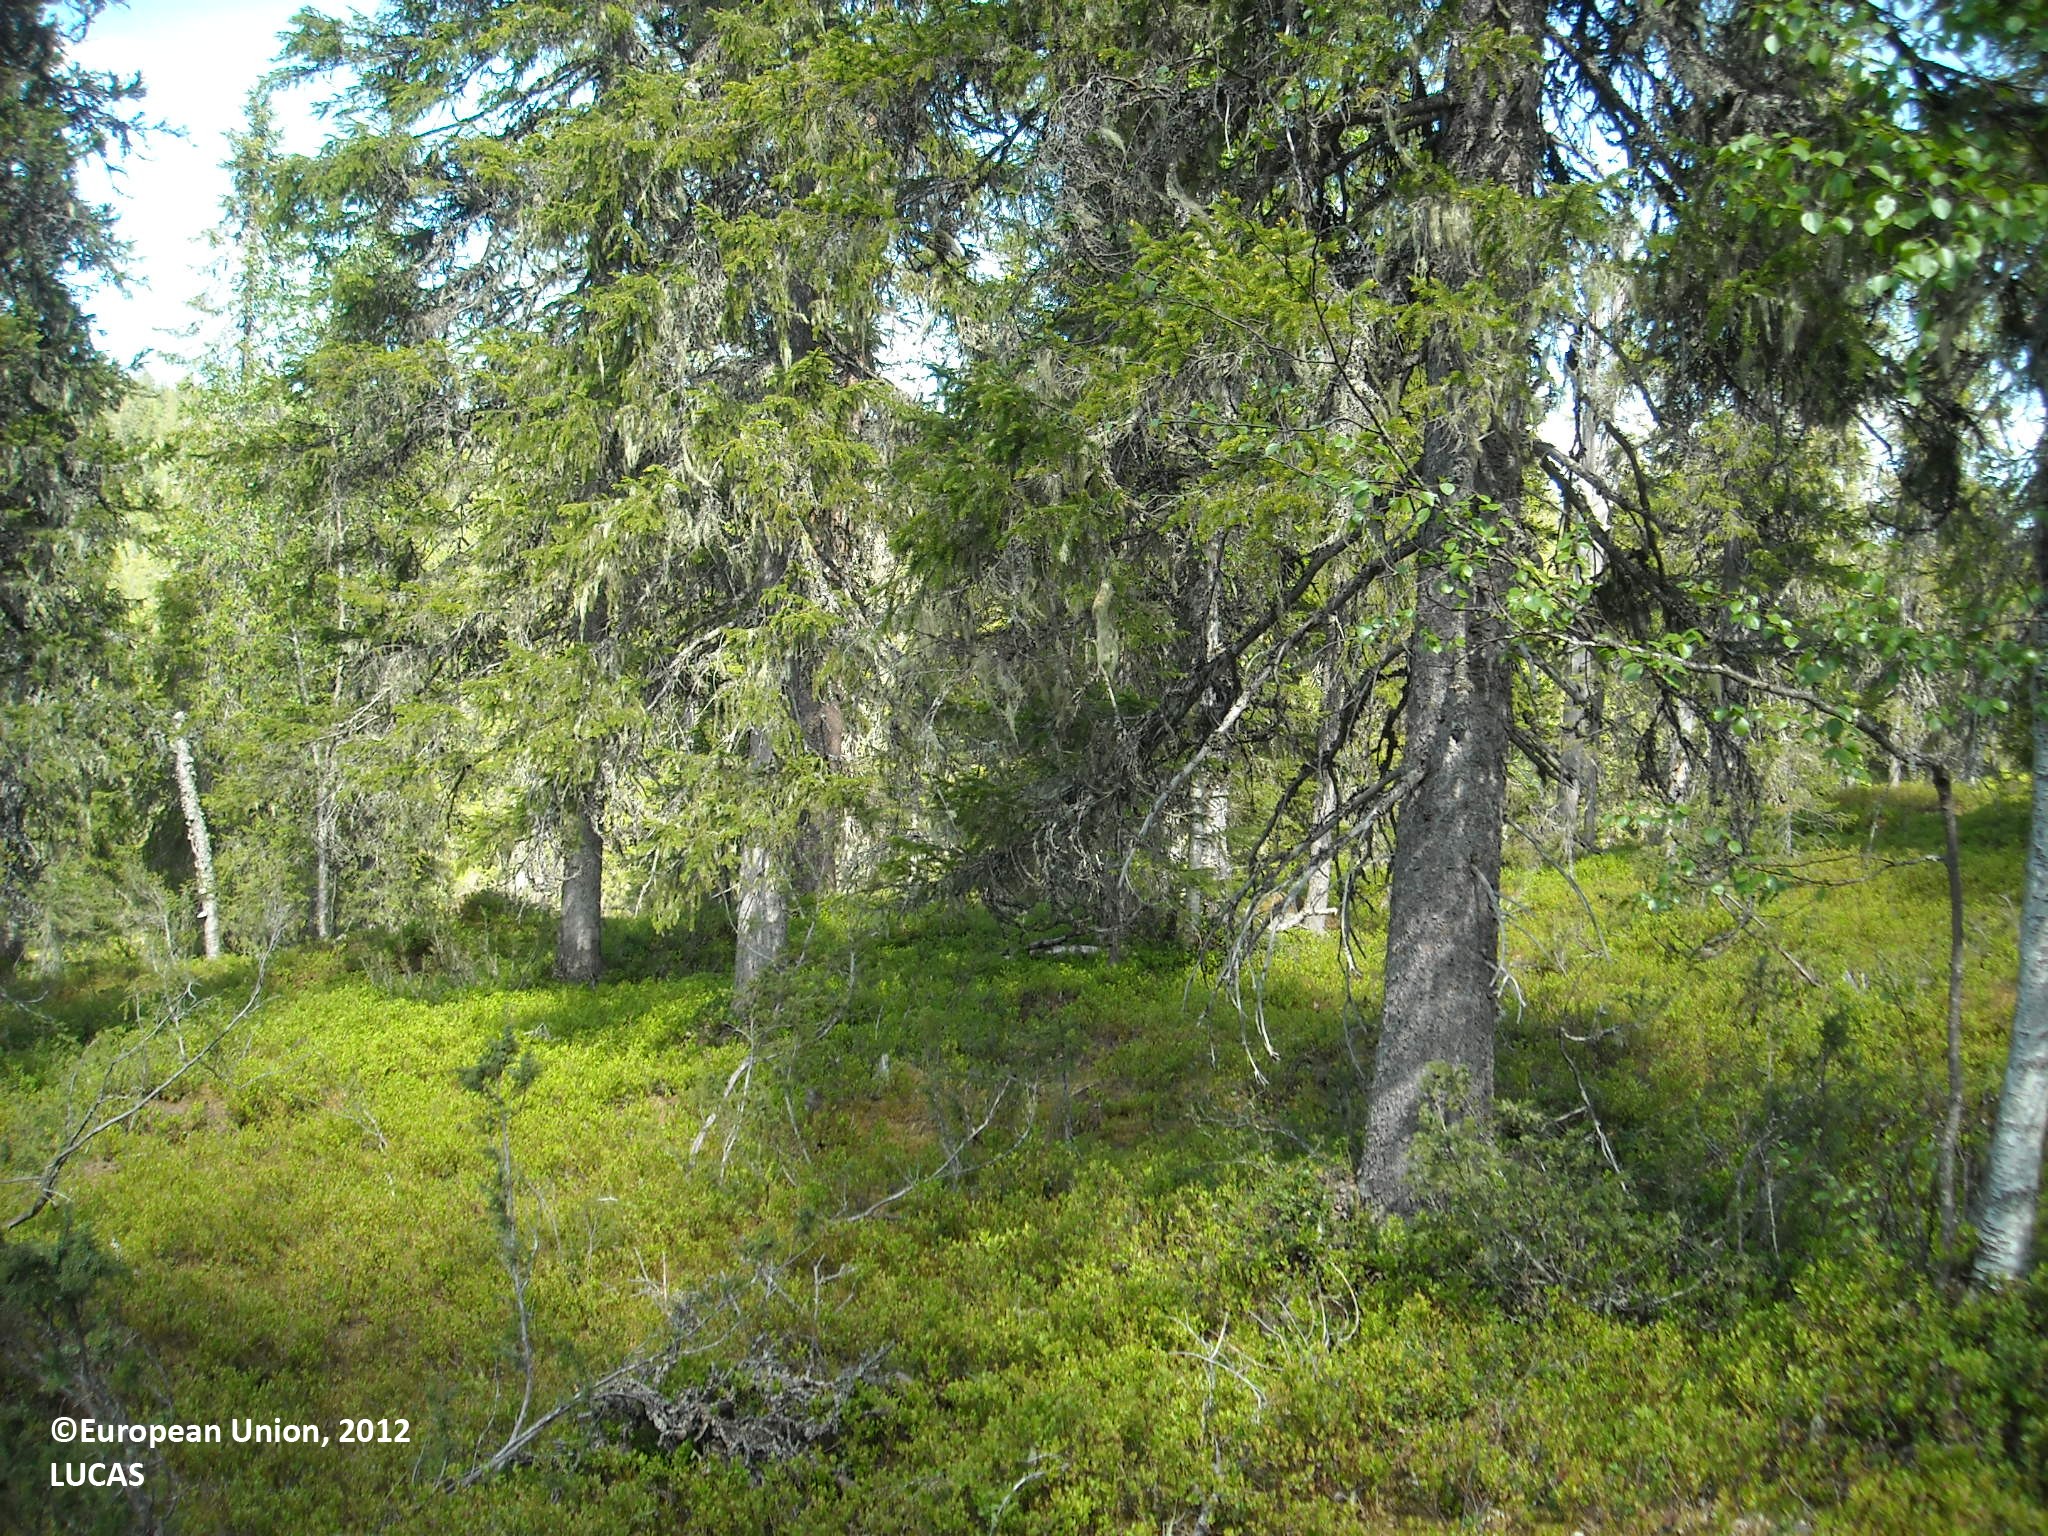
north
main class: Woodland
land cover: Spruce dominated coniferous woodland
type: boreal forest
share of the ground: > 75 %
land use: Forestry
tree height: > 5 m
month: June
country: FI
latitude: 65.7817
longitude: 27.9892
